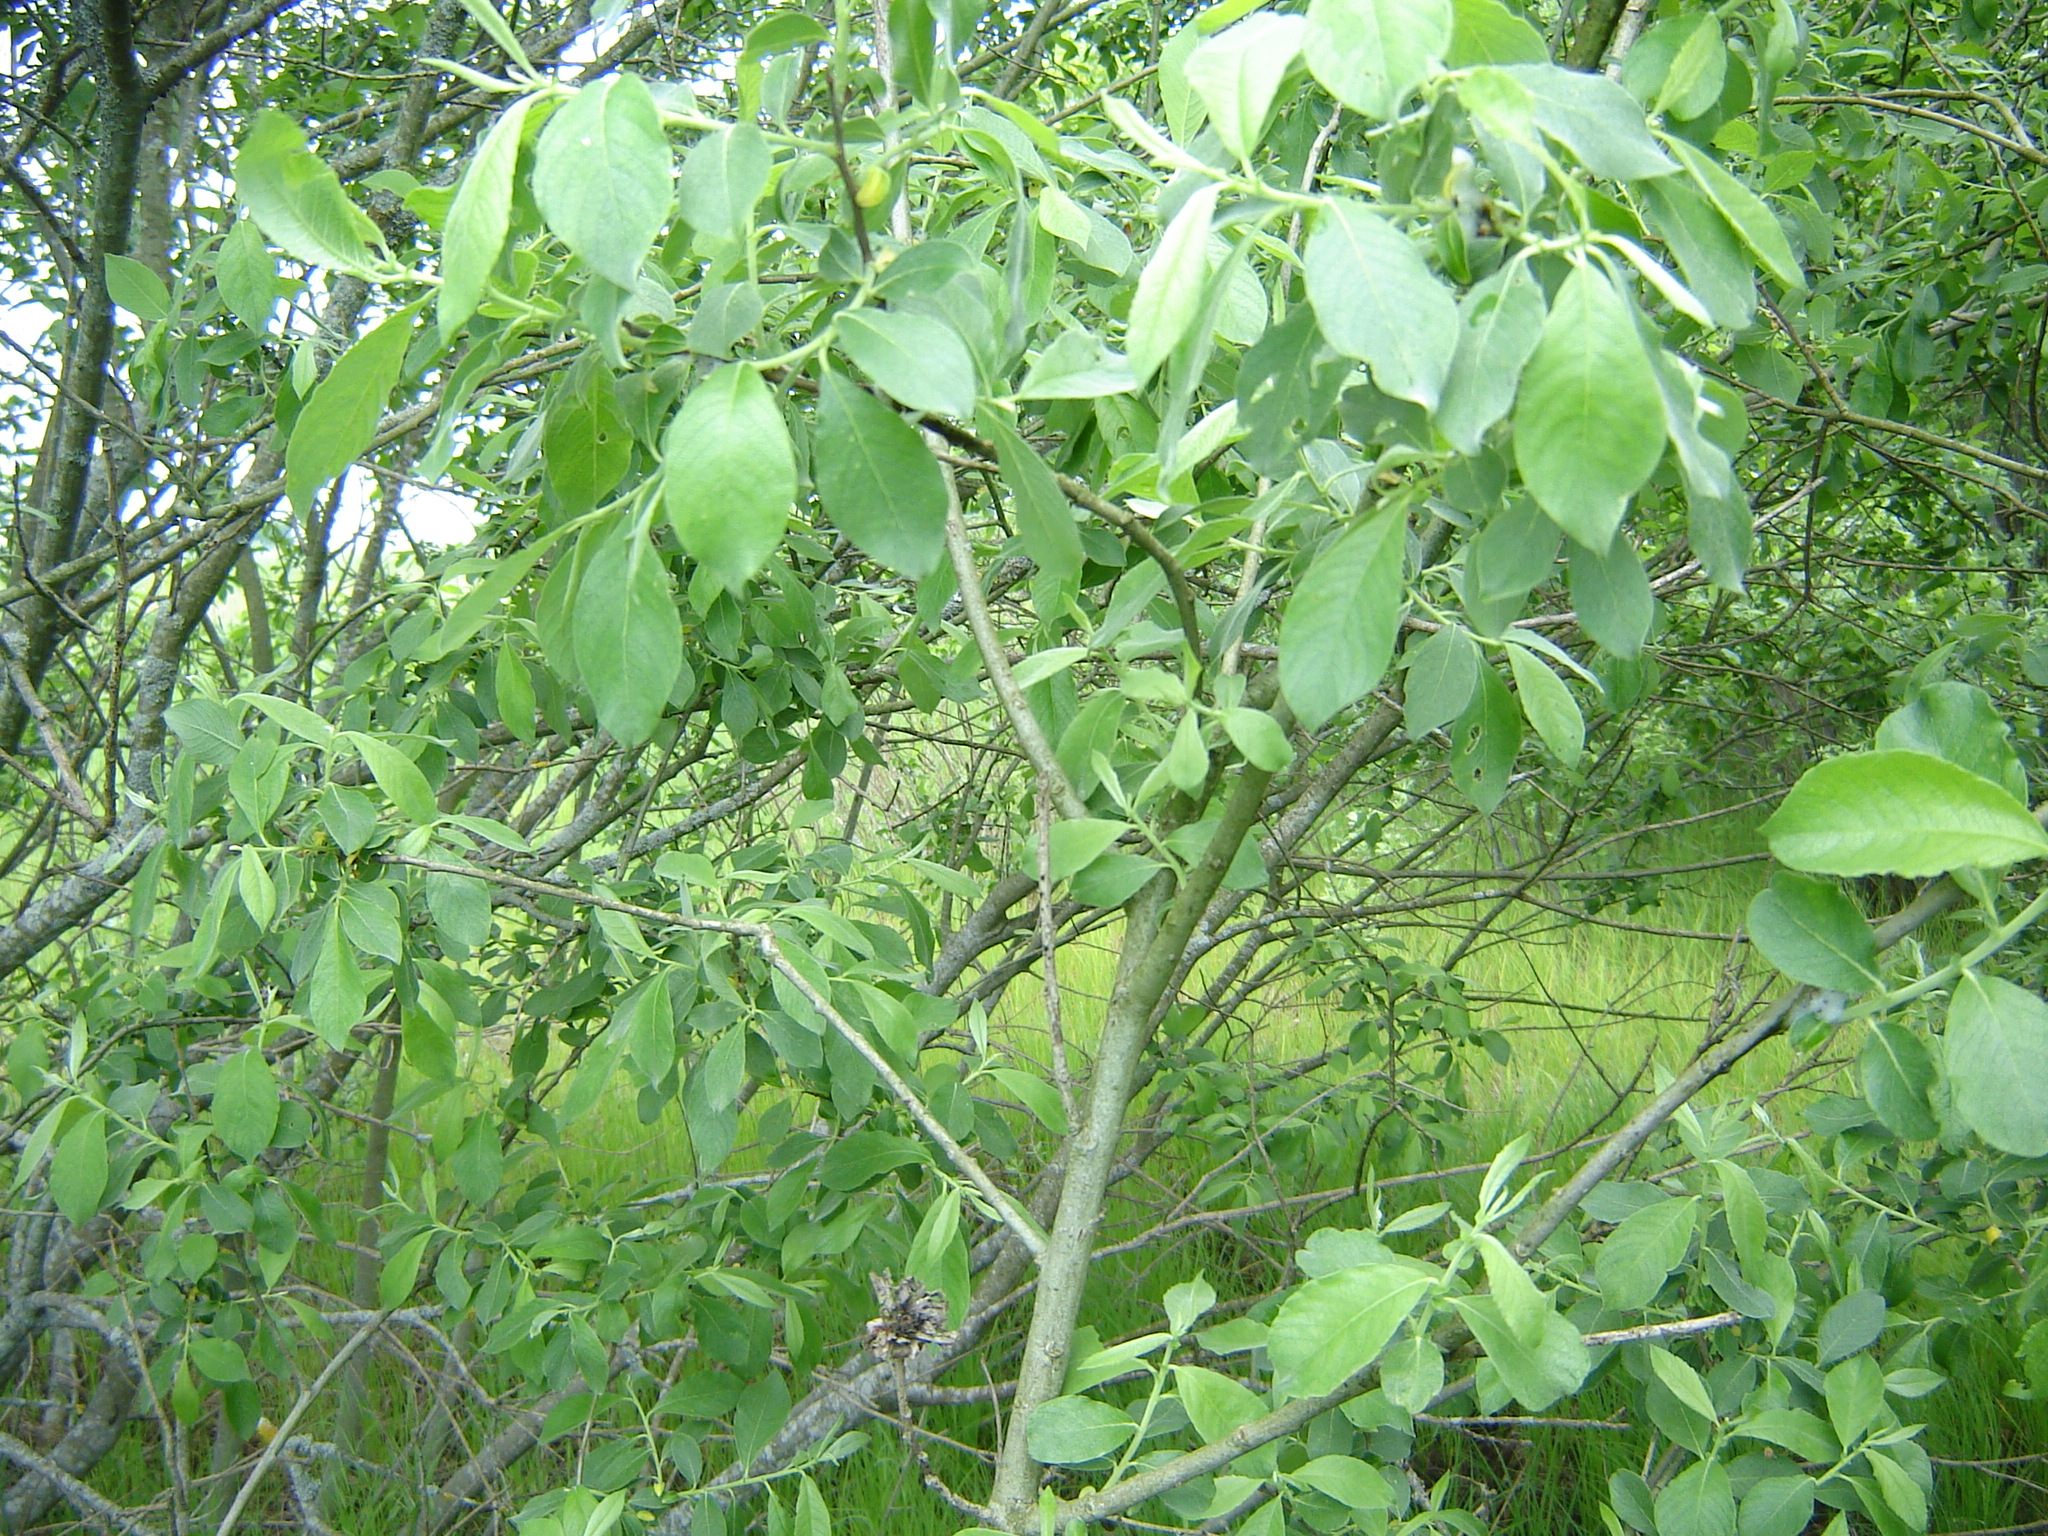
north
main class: Woodland
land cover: Broadleaved woodland
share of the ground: 50 - 75 %
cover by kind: broadleaved forest trees 70 %, herbaceous plants 30 %
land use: Semi-natural and natural areas not in use
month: June
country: LT
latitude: 55.8756
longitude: 25.3840
